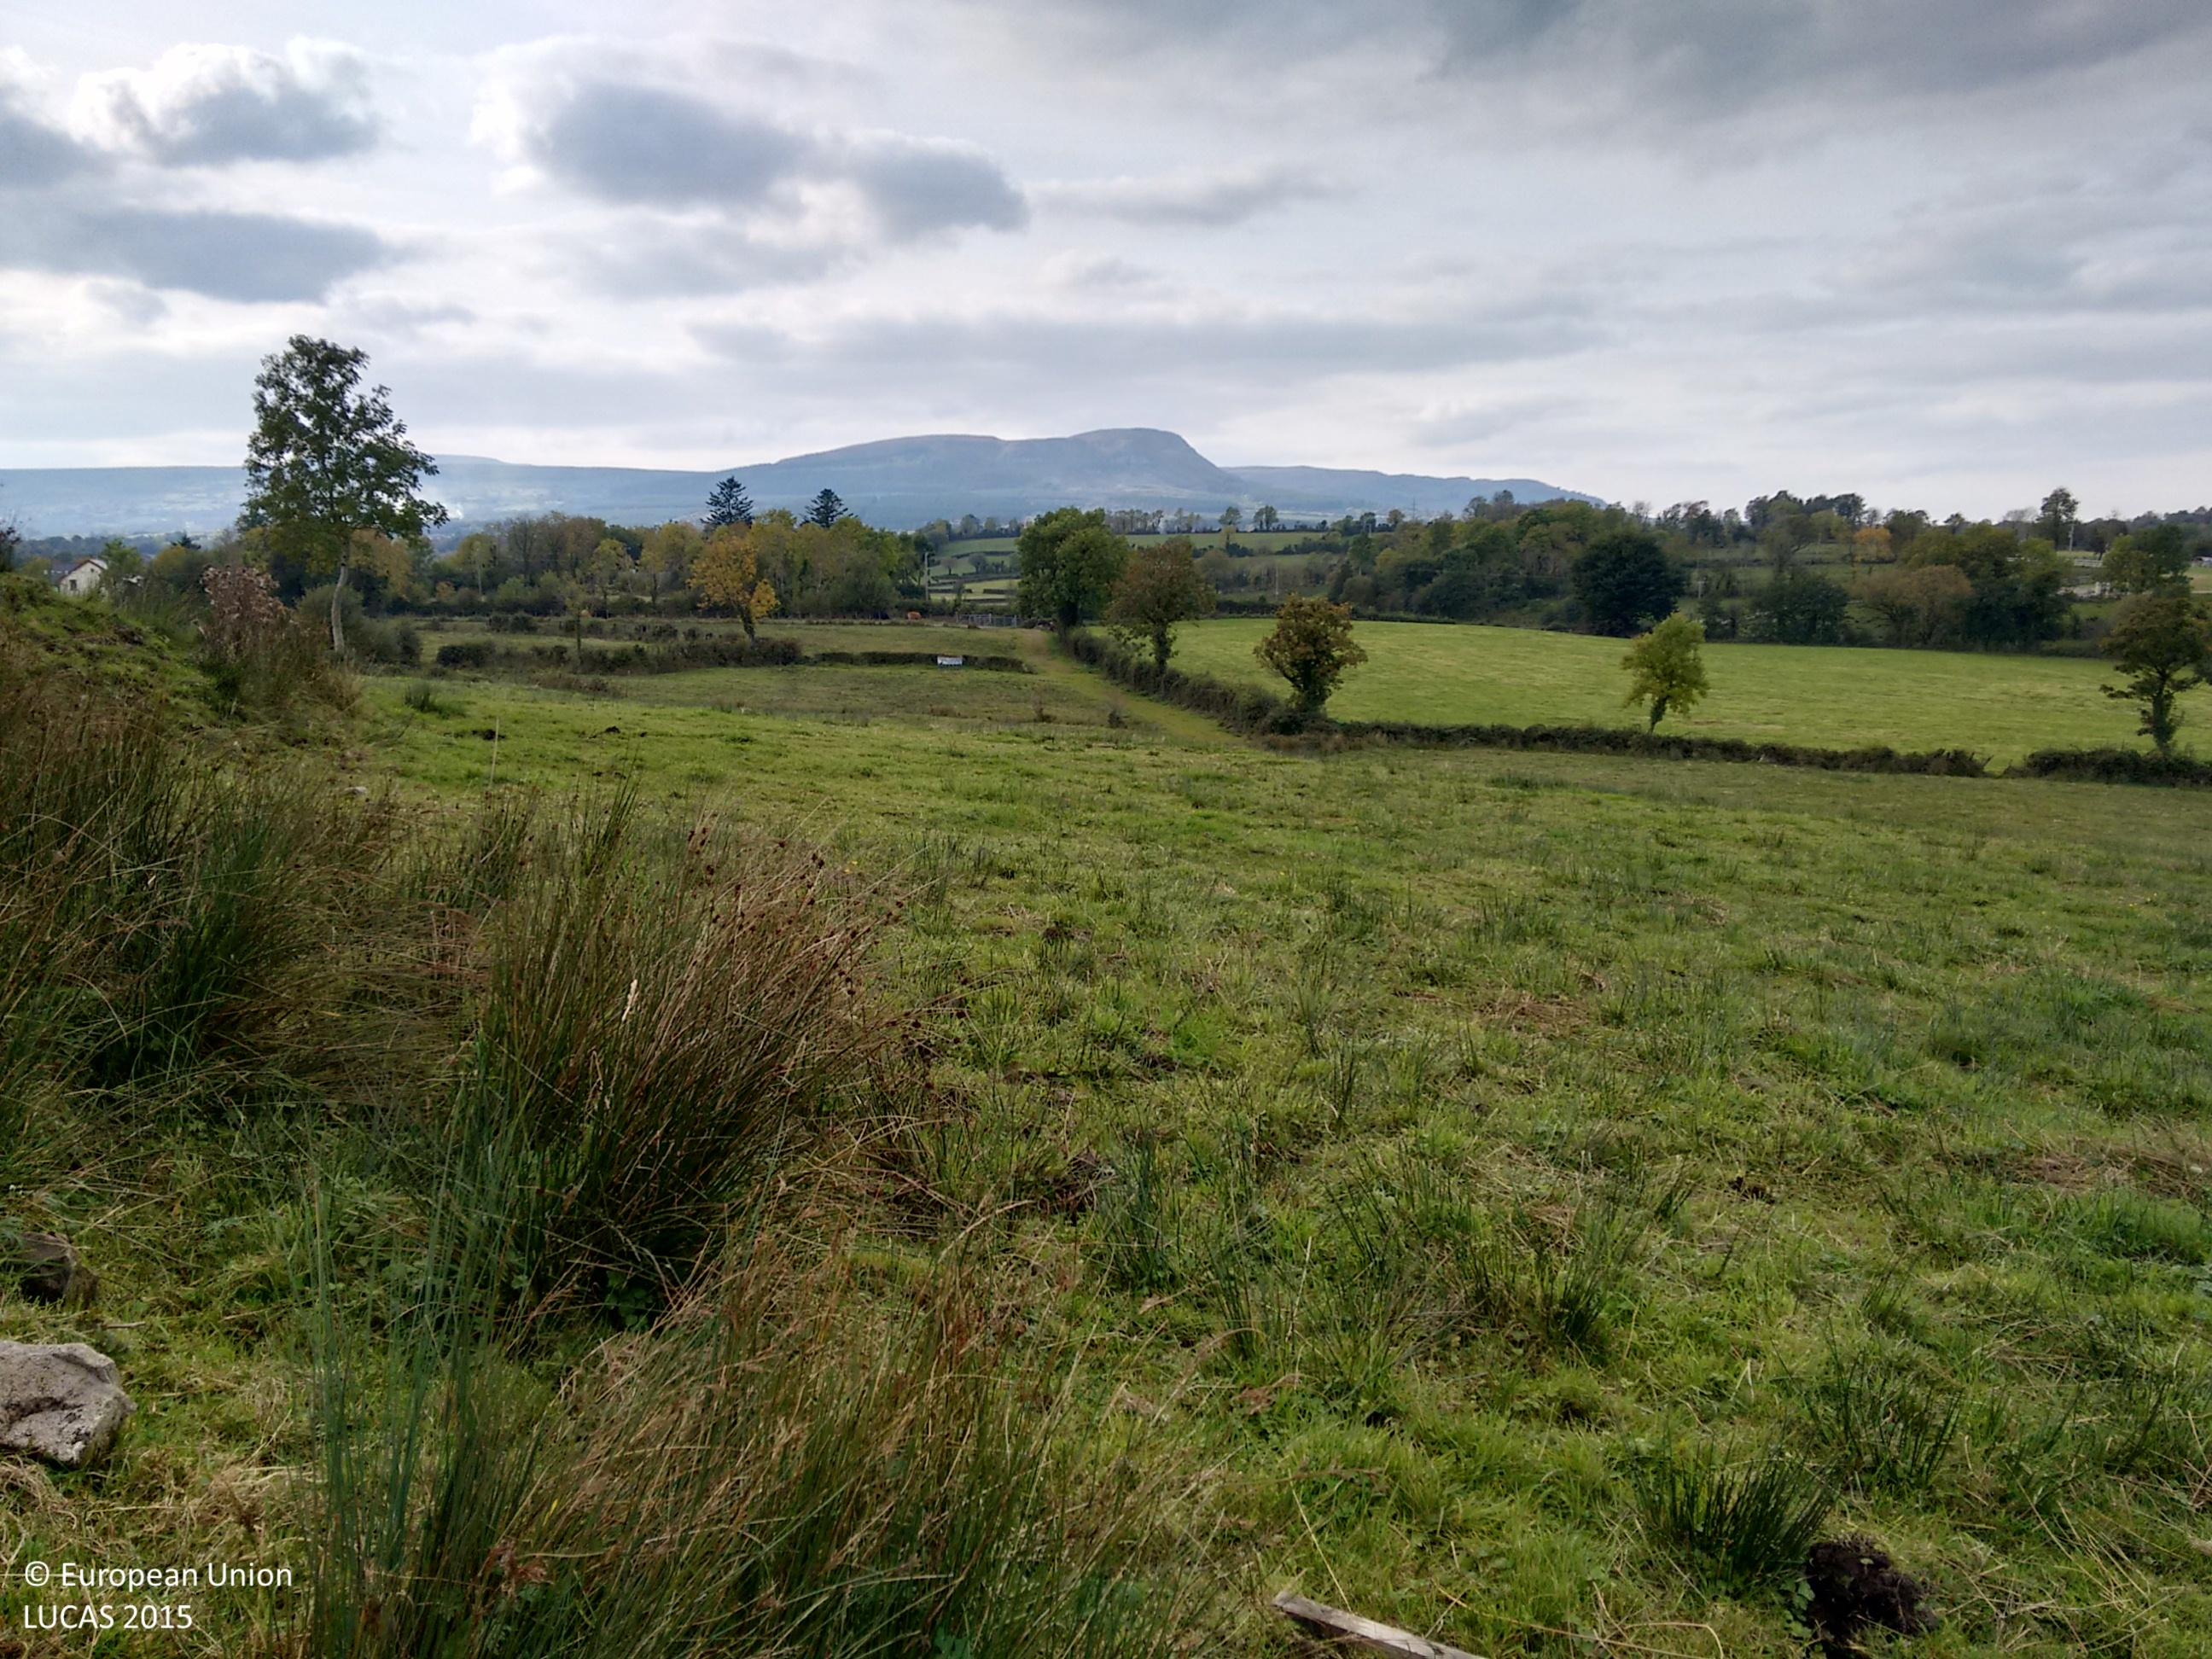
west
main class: Grassland
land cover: Grassland without tree/shrub cover
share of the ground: > 75 %
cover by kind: herbaceous plants 100 %
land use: Agriculture (excluding fallow land and kitchen gardens)
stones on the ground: < 10 %
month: October
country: GB
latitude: 54.2271
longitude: -7.6642
